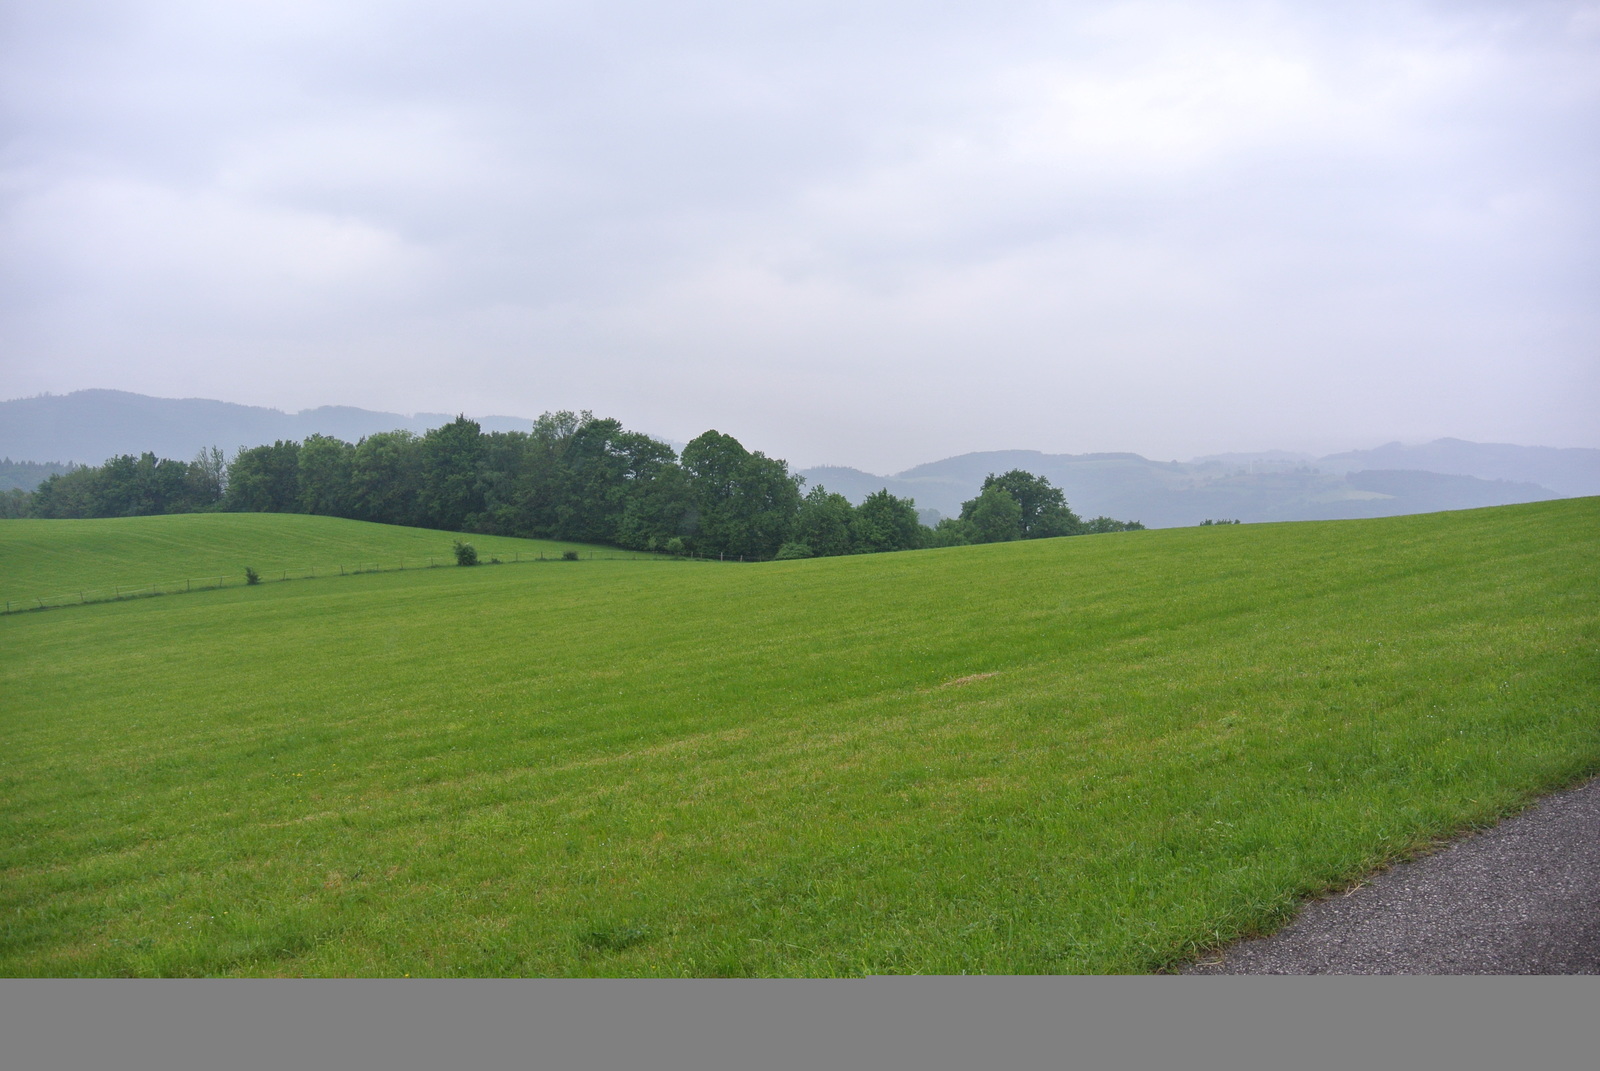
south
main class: Grassland
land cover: Grassland without tree/shrub cover
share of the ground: > 75 %
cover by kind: herbaceous plants 100 %
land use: Agriculture (excluding fallow land and kitchen gardens)
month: May
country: AT
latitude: 48.1074
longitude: 15.7914
